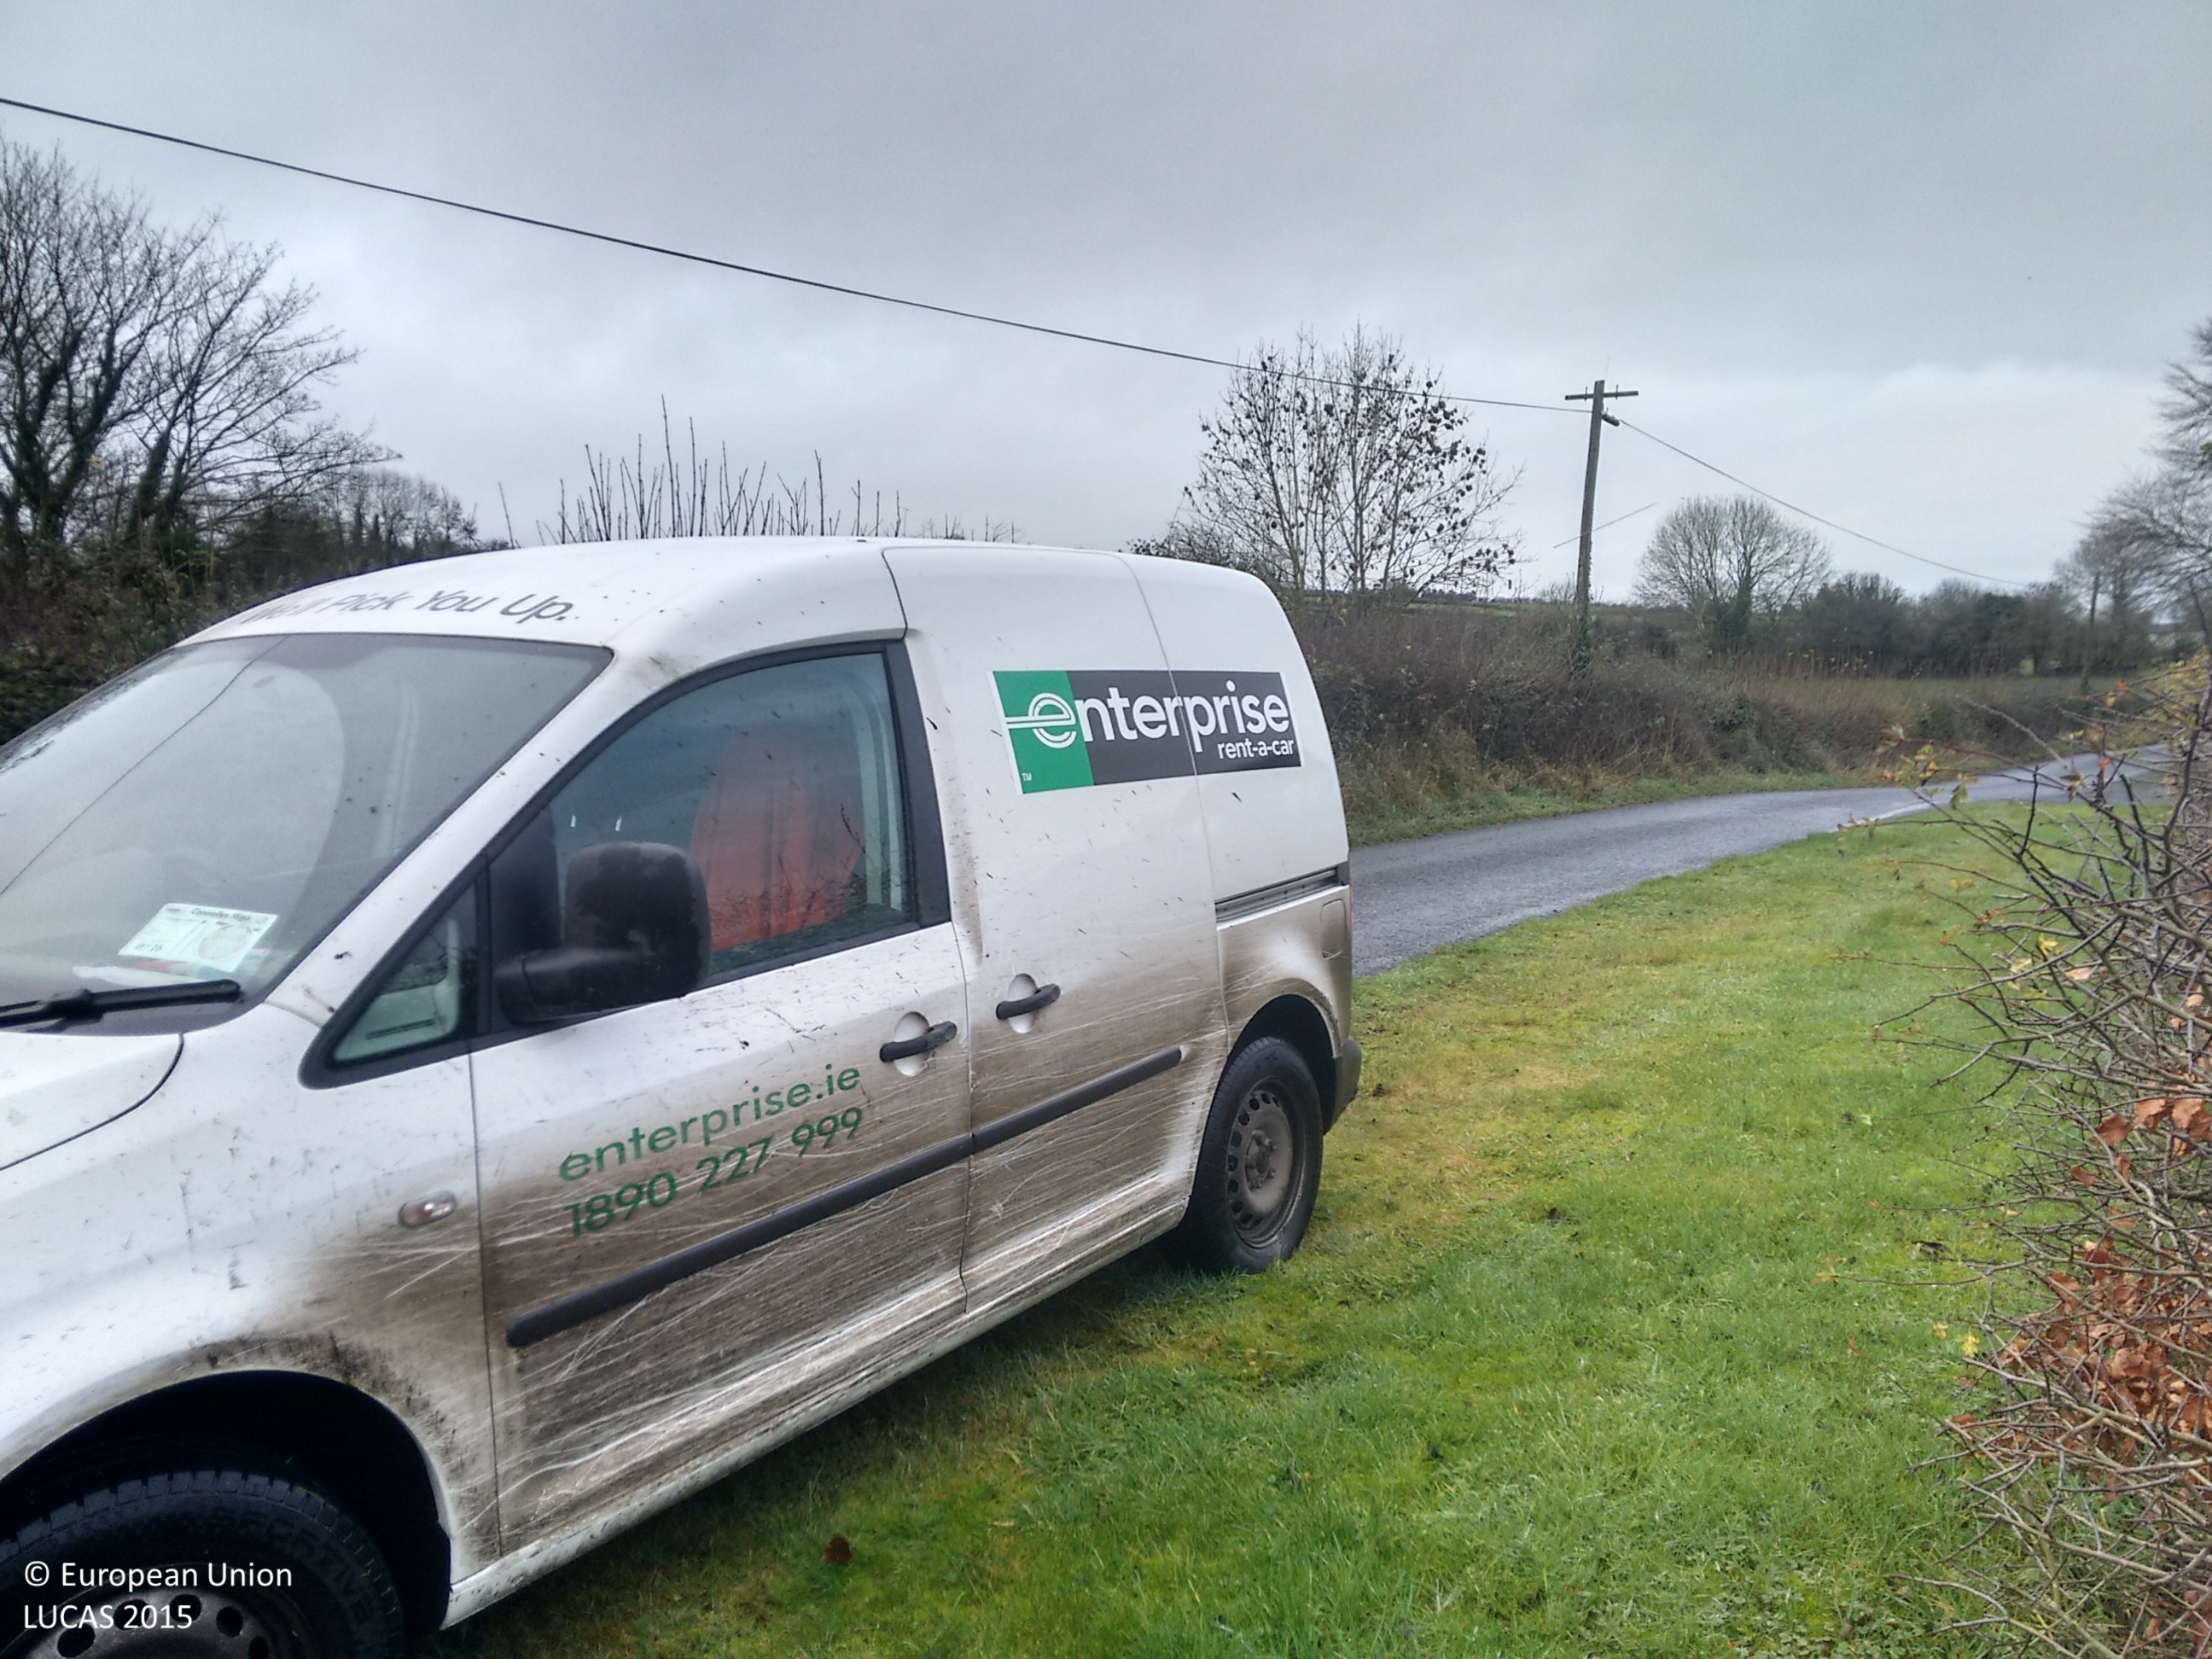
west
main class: Grassland
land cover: Grassland without tree/shrub cover
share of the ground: > 75 %
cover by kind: herbaceous plants 100 %
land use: Agriculture (excluding fallow land and kitchen gardens)
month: December
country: IE
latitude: 53.4418
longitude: -7.6103
